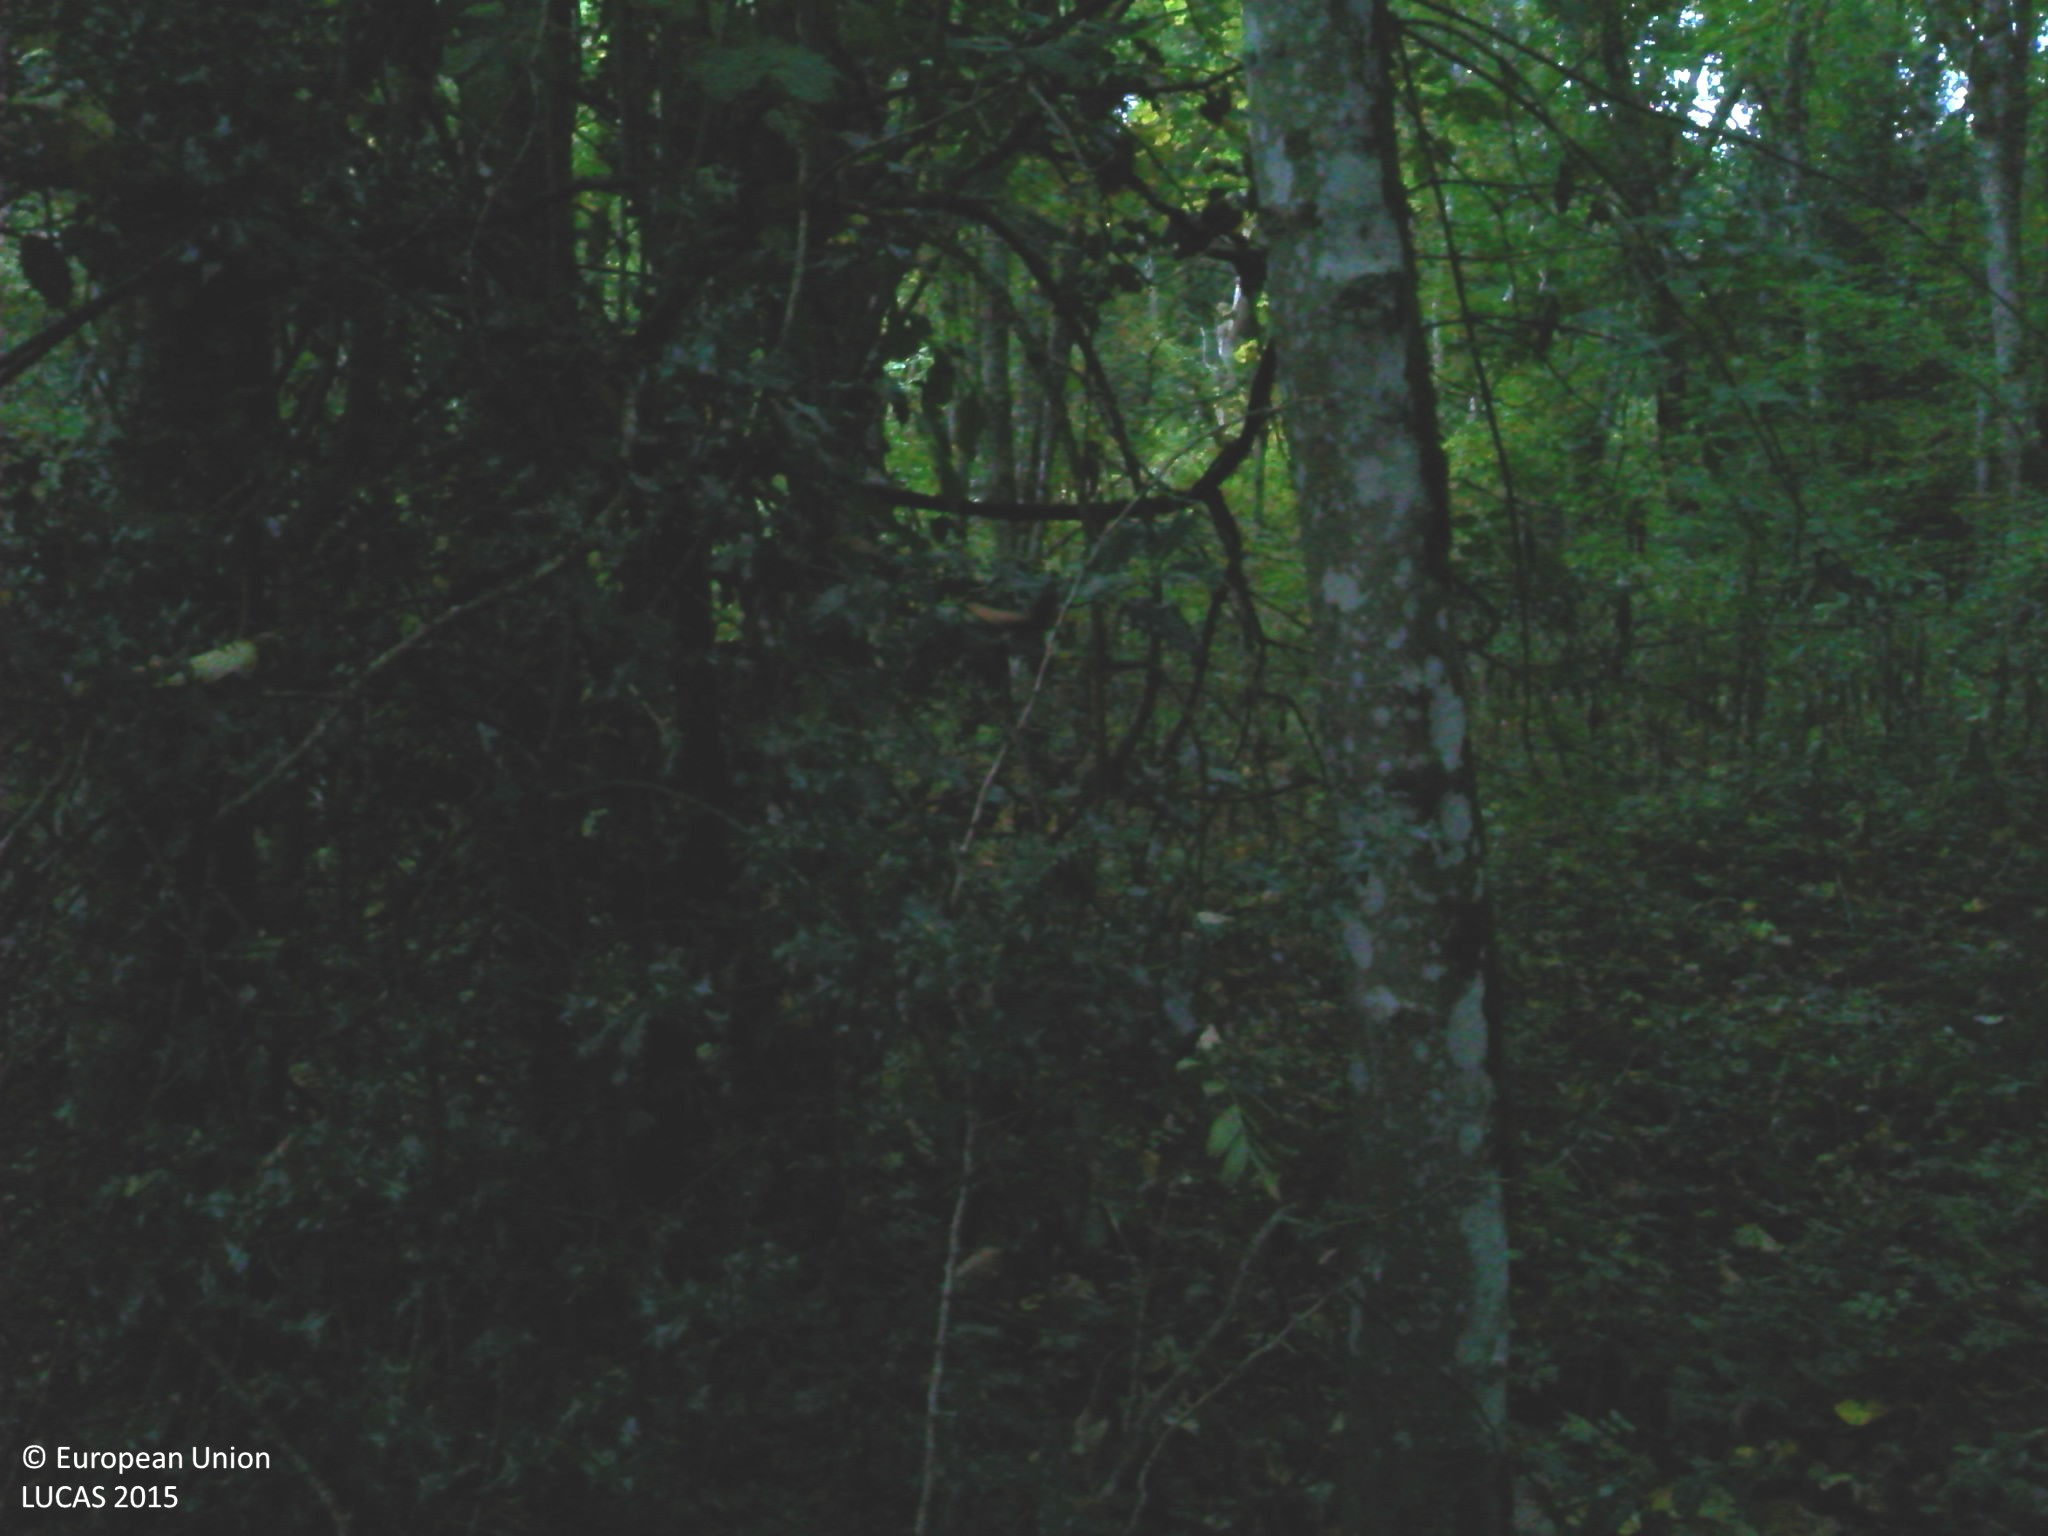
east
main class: Woodland
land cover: Broadleaved woodland
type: mesophytic deciduous forest
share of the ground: > 75 %
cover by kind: broadleaved forest trees 85 %, shrubs 10 %, herbaceous plants 5 %
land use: Forestry
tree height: > 5 m
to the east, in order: Broadleaved woodland; Dry stone walls; Tracks; Other mixed woodland; Broadleaved woodland
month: October
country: FR
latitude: 45.8211
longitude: 3.6816
